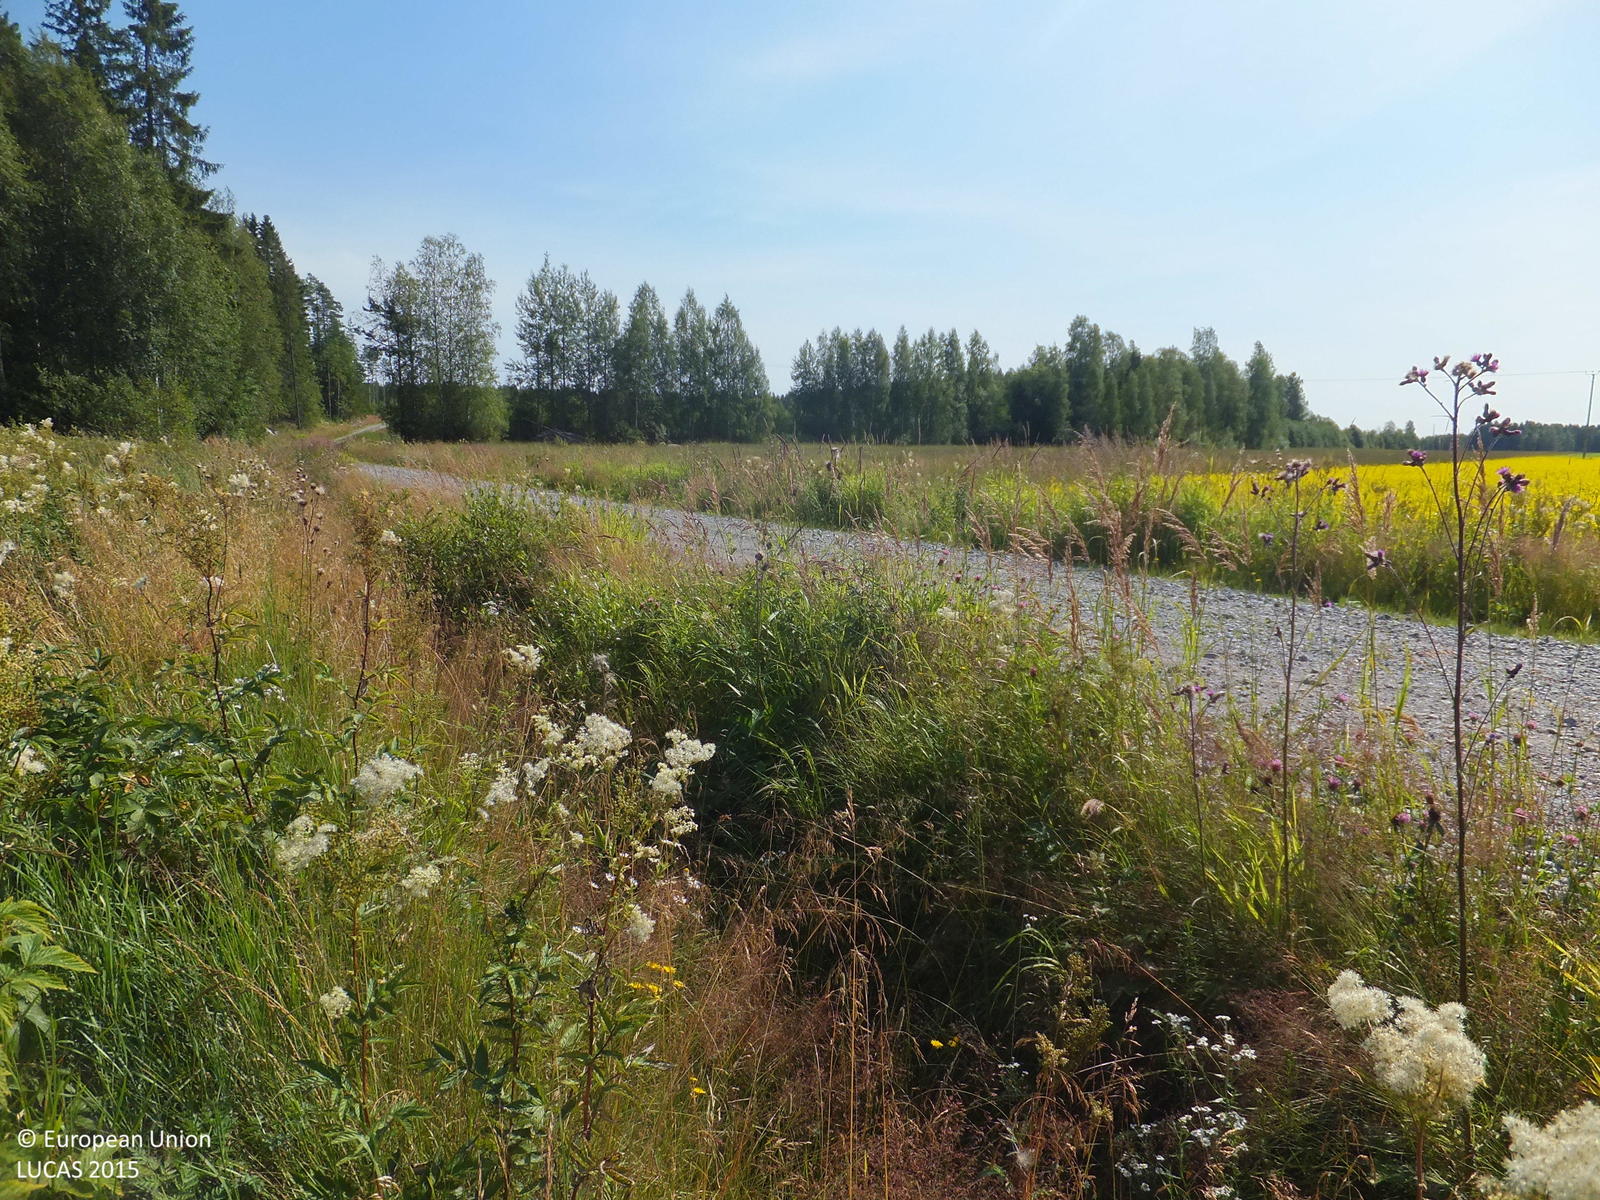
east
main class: Grassland
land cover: Grassland without tree/shrub cover
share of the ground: > 75 %
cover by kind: herbaceous plants 100 %
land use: Agriculture (excluding fallow land and kitchen gardens)
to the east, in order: Grassland without tree/shrub cover; Ditches and canals; Grass margins; Paved roads, cycling and walking lanes; Grass margins; Ditches and canals; Other coniferous woodland; Ditches and canals; Paved roads, cycling and walking lanes; Electric lines; Paved roads, cycling and walking lanes; Ditches and canals; Pine dominated mixed woodland
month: August
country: FI
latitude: 63.2942
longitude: 22.7573
